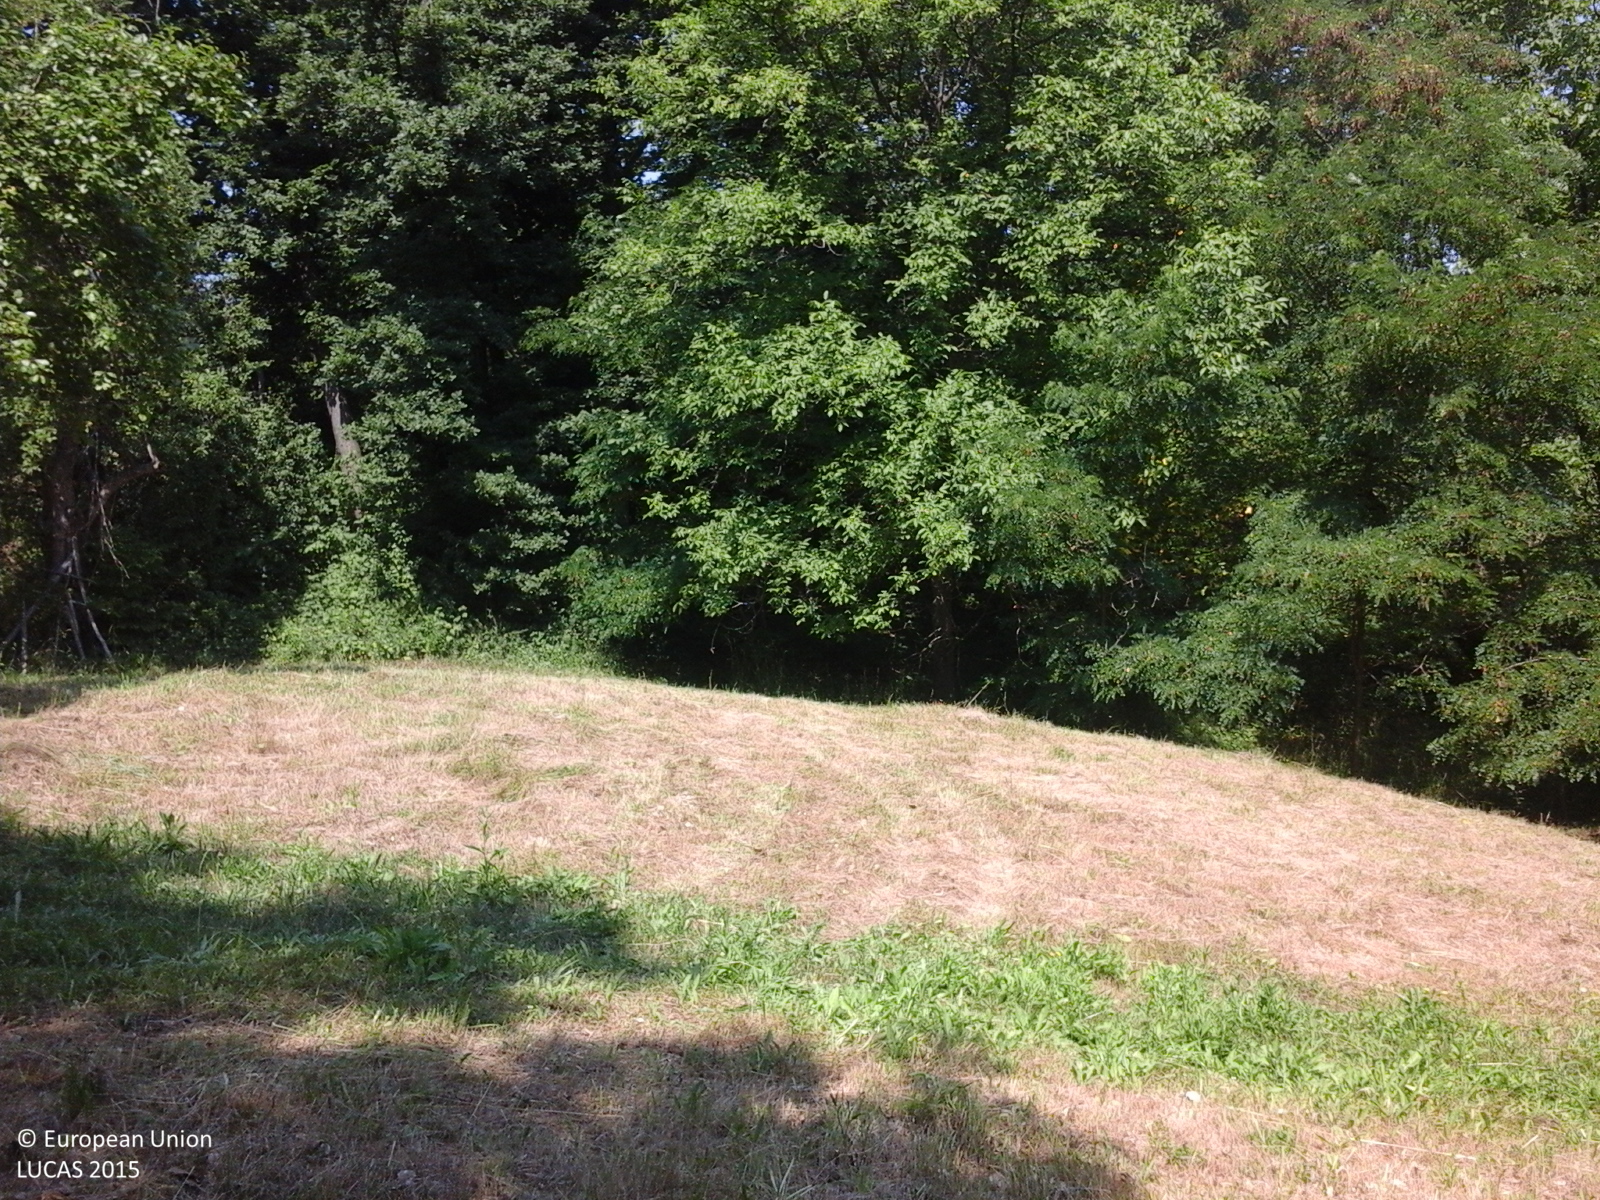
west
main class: Woodland
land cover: Broadleaved woodland
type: non-riverine alder, birch or aspen forest
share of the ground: > 75 %
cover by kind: broadleaved forest trees 100 %
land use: Forestry
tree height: > 5 m
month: July
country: RO
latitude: 45.0690
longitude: 24.5953
